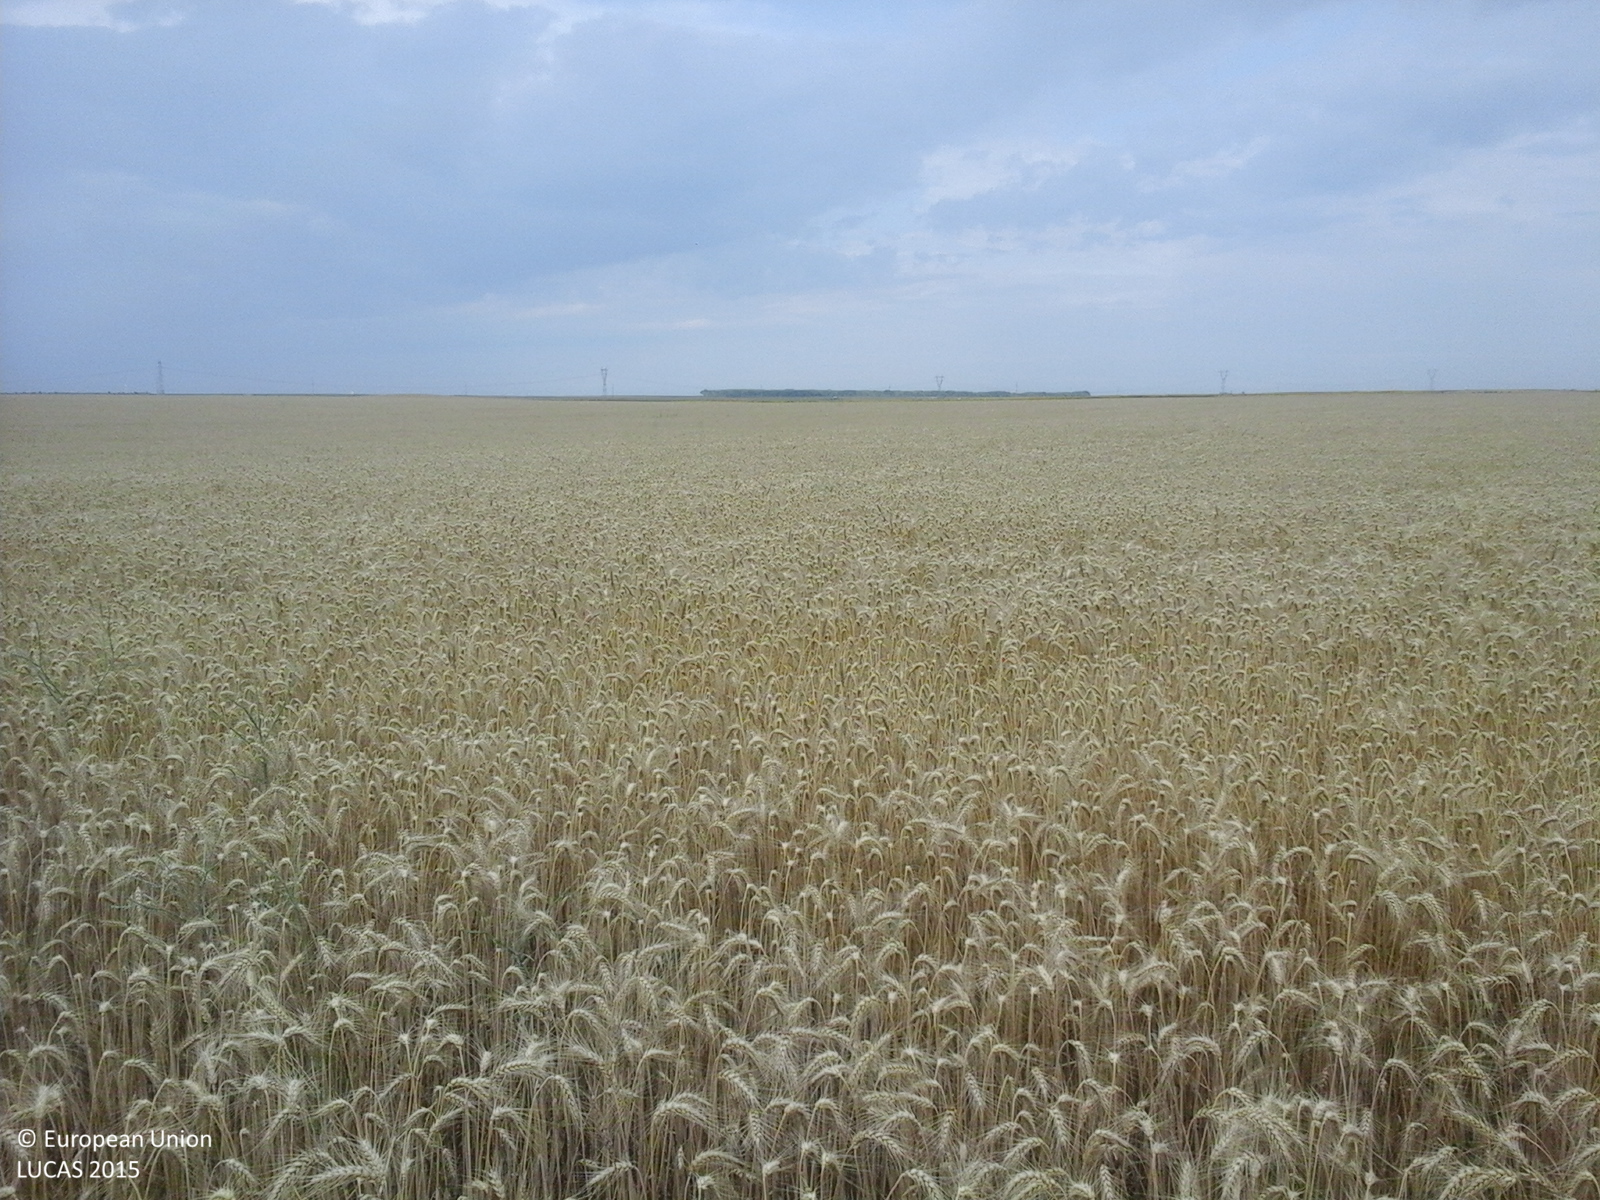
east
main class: Cropland
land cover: Common wheat
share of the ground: > 75 %
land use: Agriculture (excluding fallow land and kitchen gardens)
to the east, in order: Common wheat
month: July
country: RO
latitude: 43.9678
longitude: 24.3599
